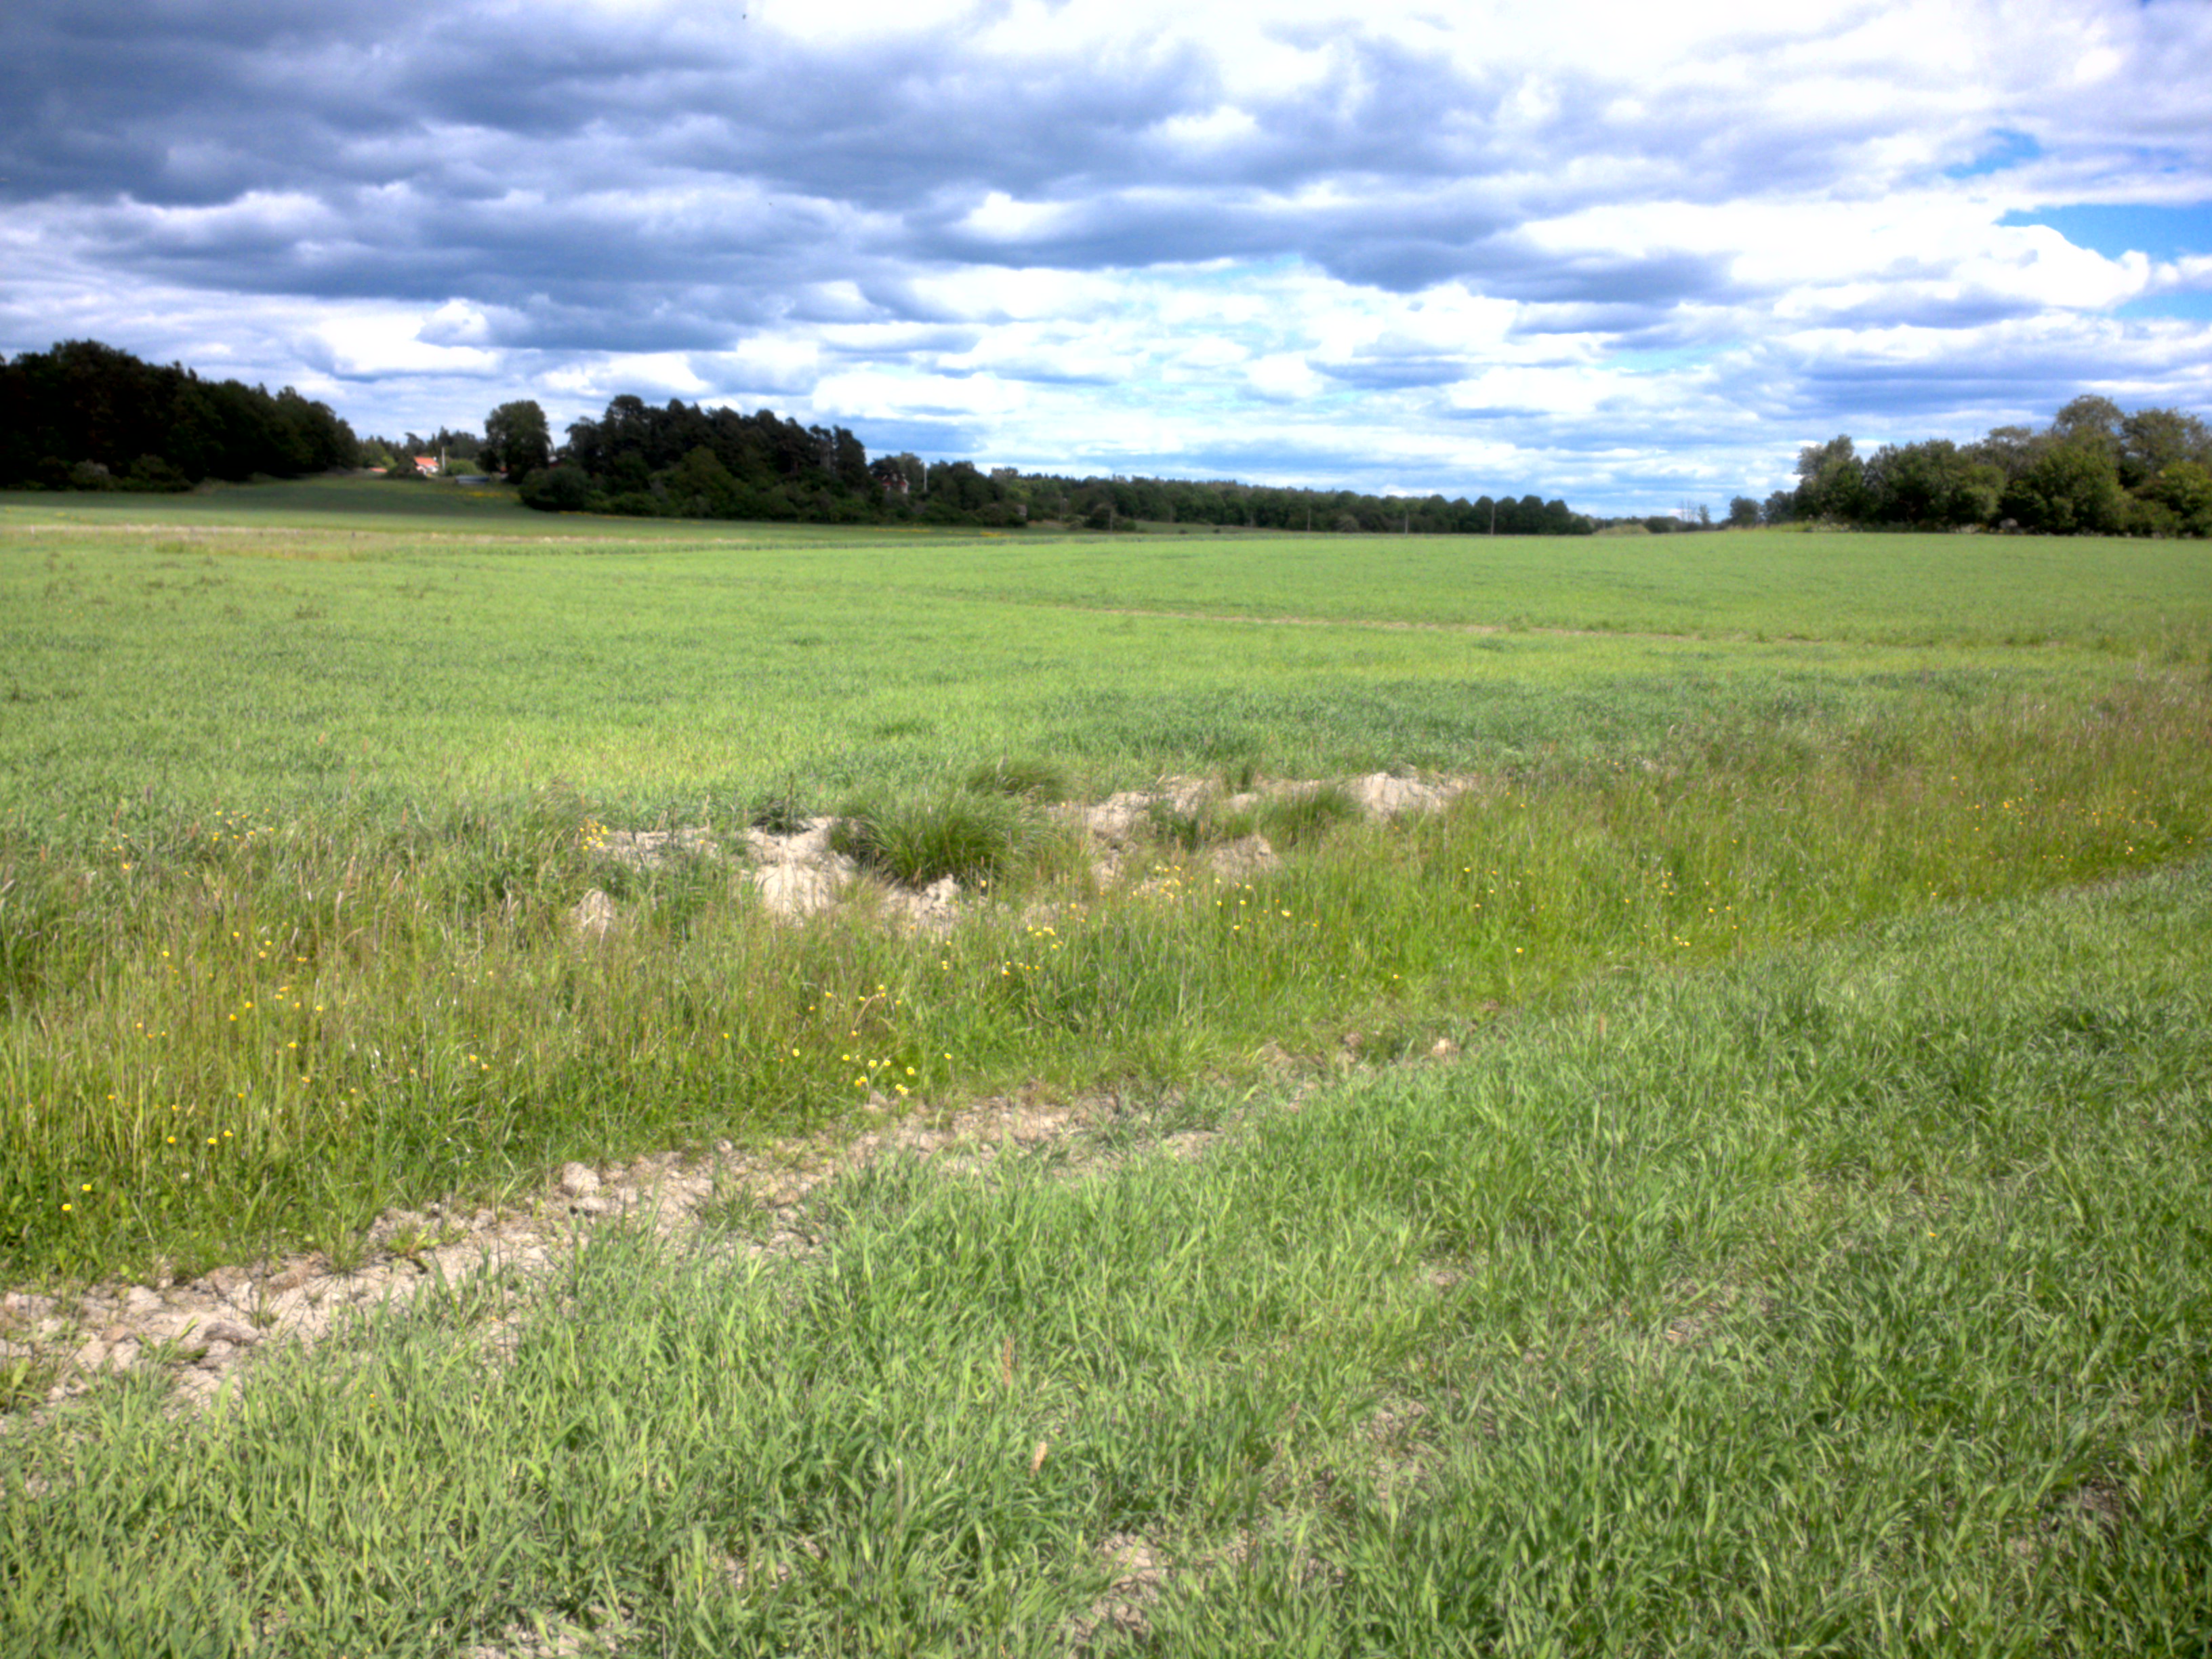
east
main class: Cropland
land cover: Barley
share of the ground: > 75 %
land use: Agriculture (excluding fallow land and kitchen gardens)
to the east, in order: Barley; Grass margins; Ditches and canals; Grass margins; Barley; Grass margins; Ditches and canals; Grass margins; Barley
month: June
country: SE
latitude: 59.4095
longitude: 17.6953
